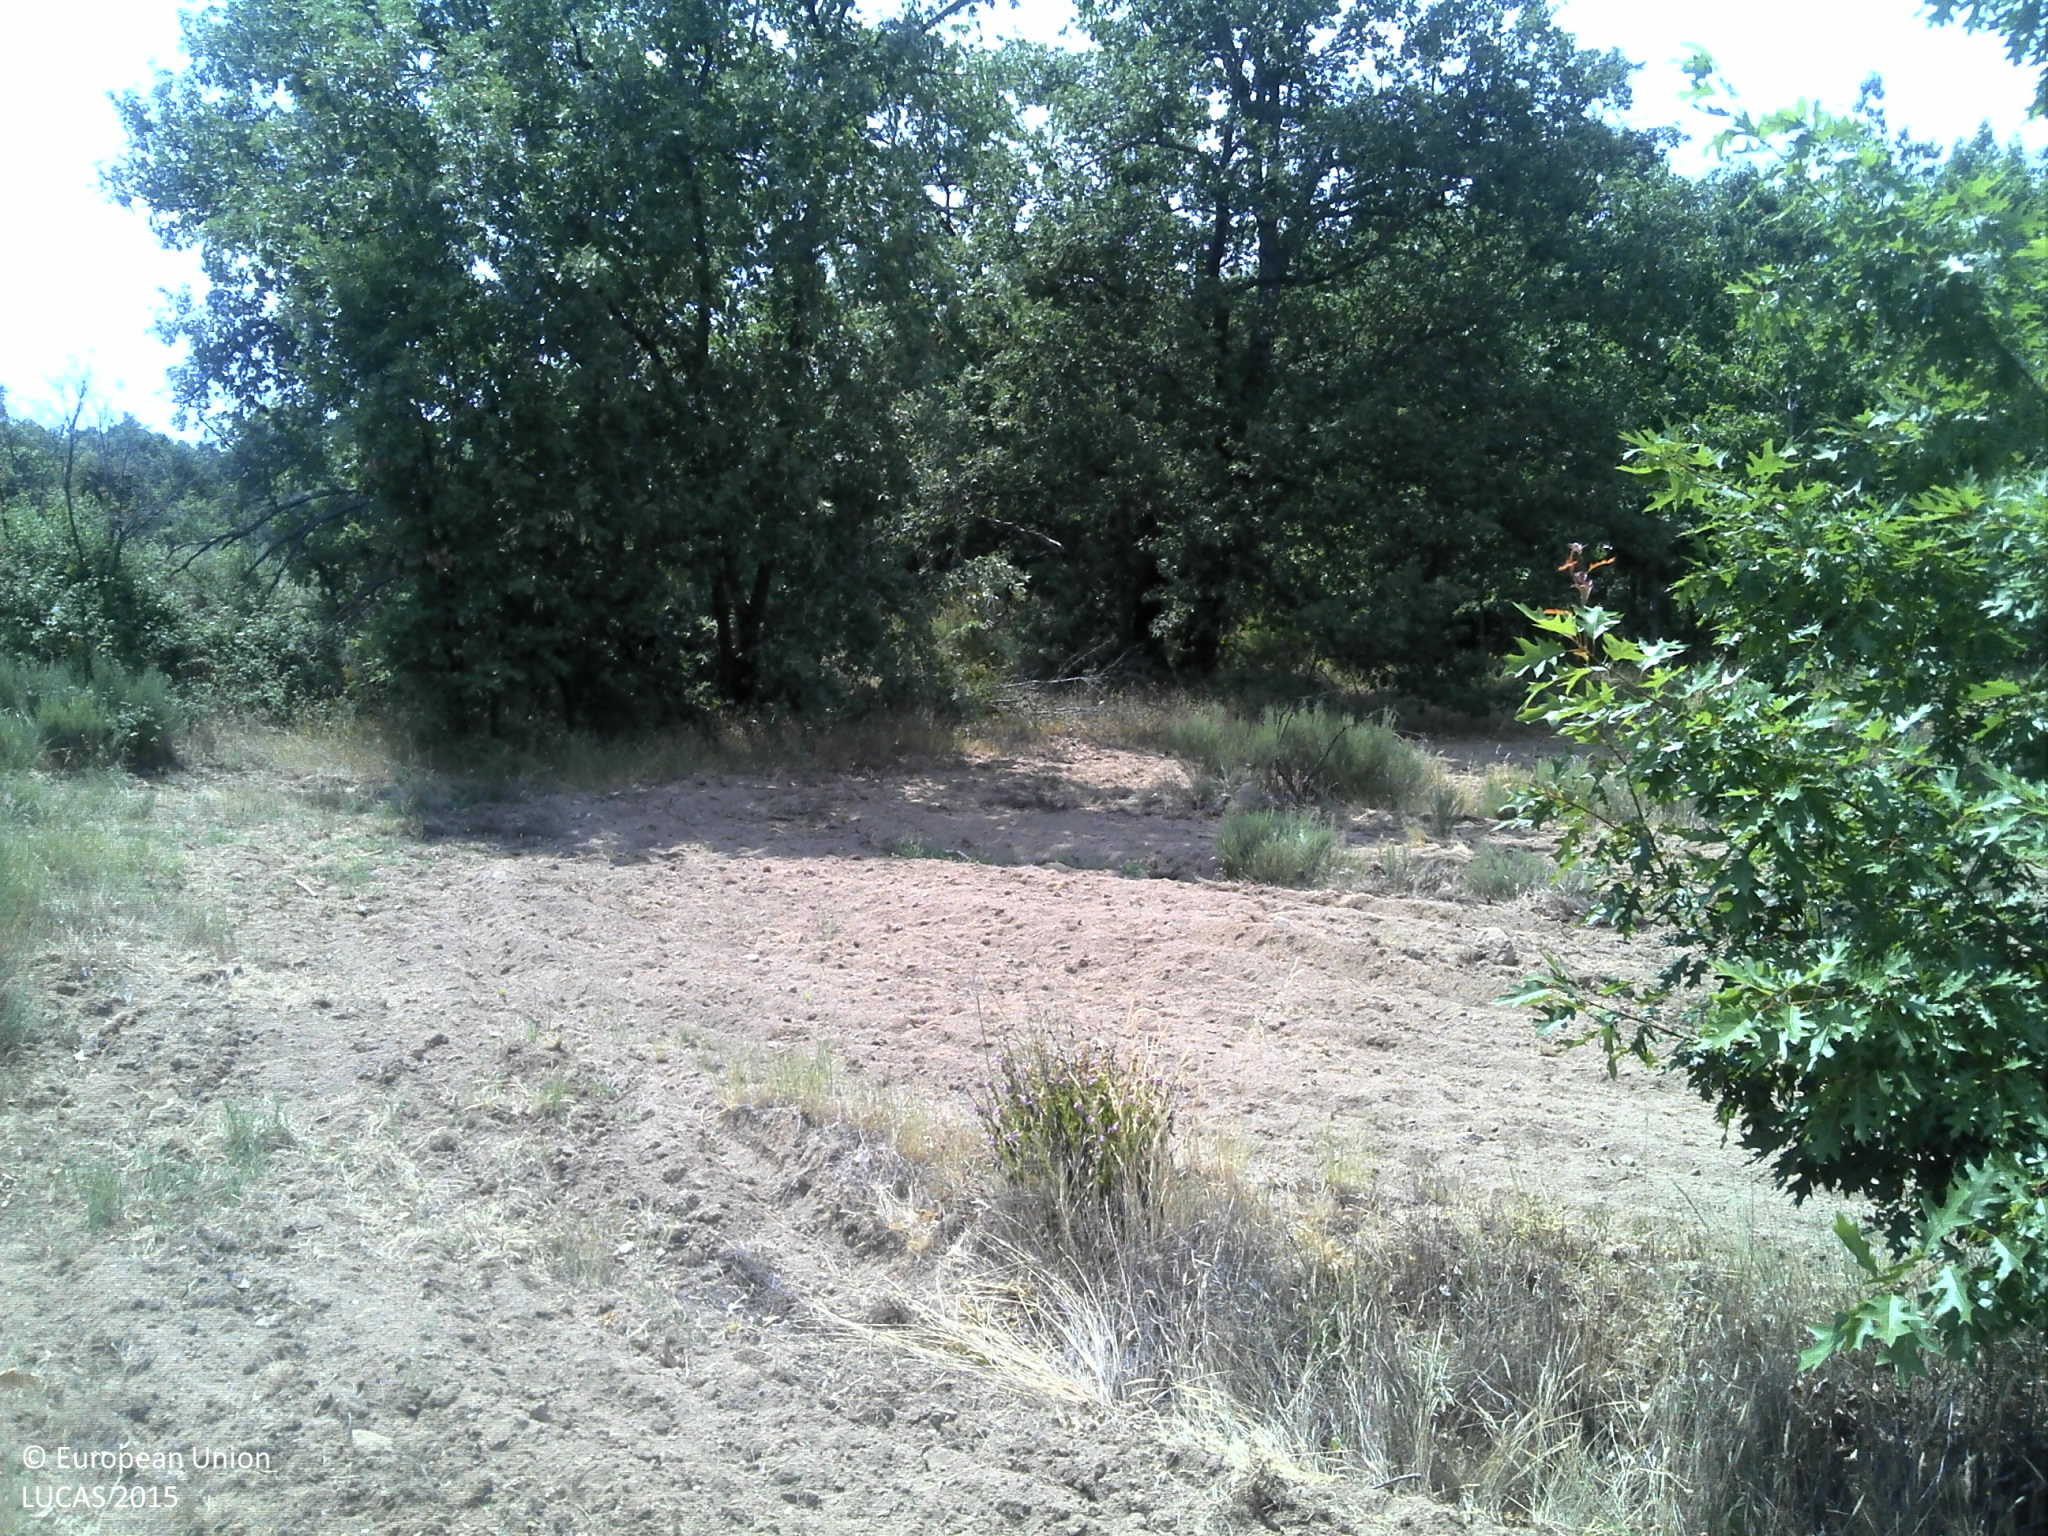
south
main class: Shrubland
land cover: Shrubland without tree cover
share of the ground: 50 - 75 %
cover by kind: shrubs 60 %, herbaceous plants 30 %, unconsolidated bare surface 5 %
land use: Abandoned areas
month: June
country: PT
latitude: 40.3011
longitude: -7.3154
